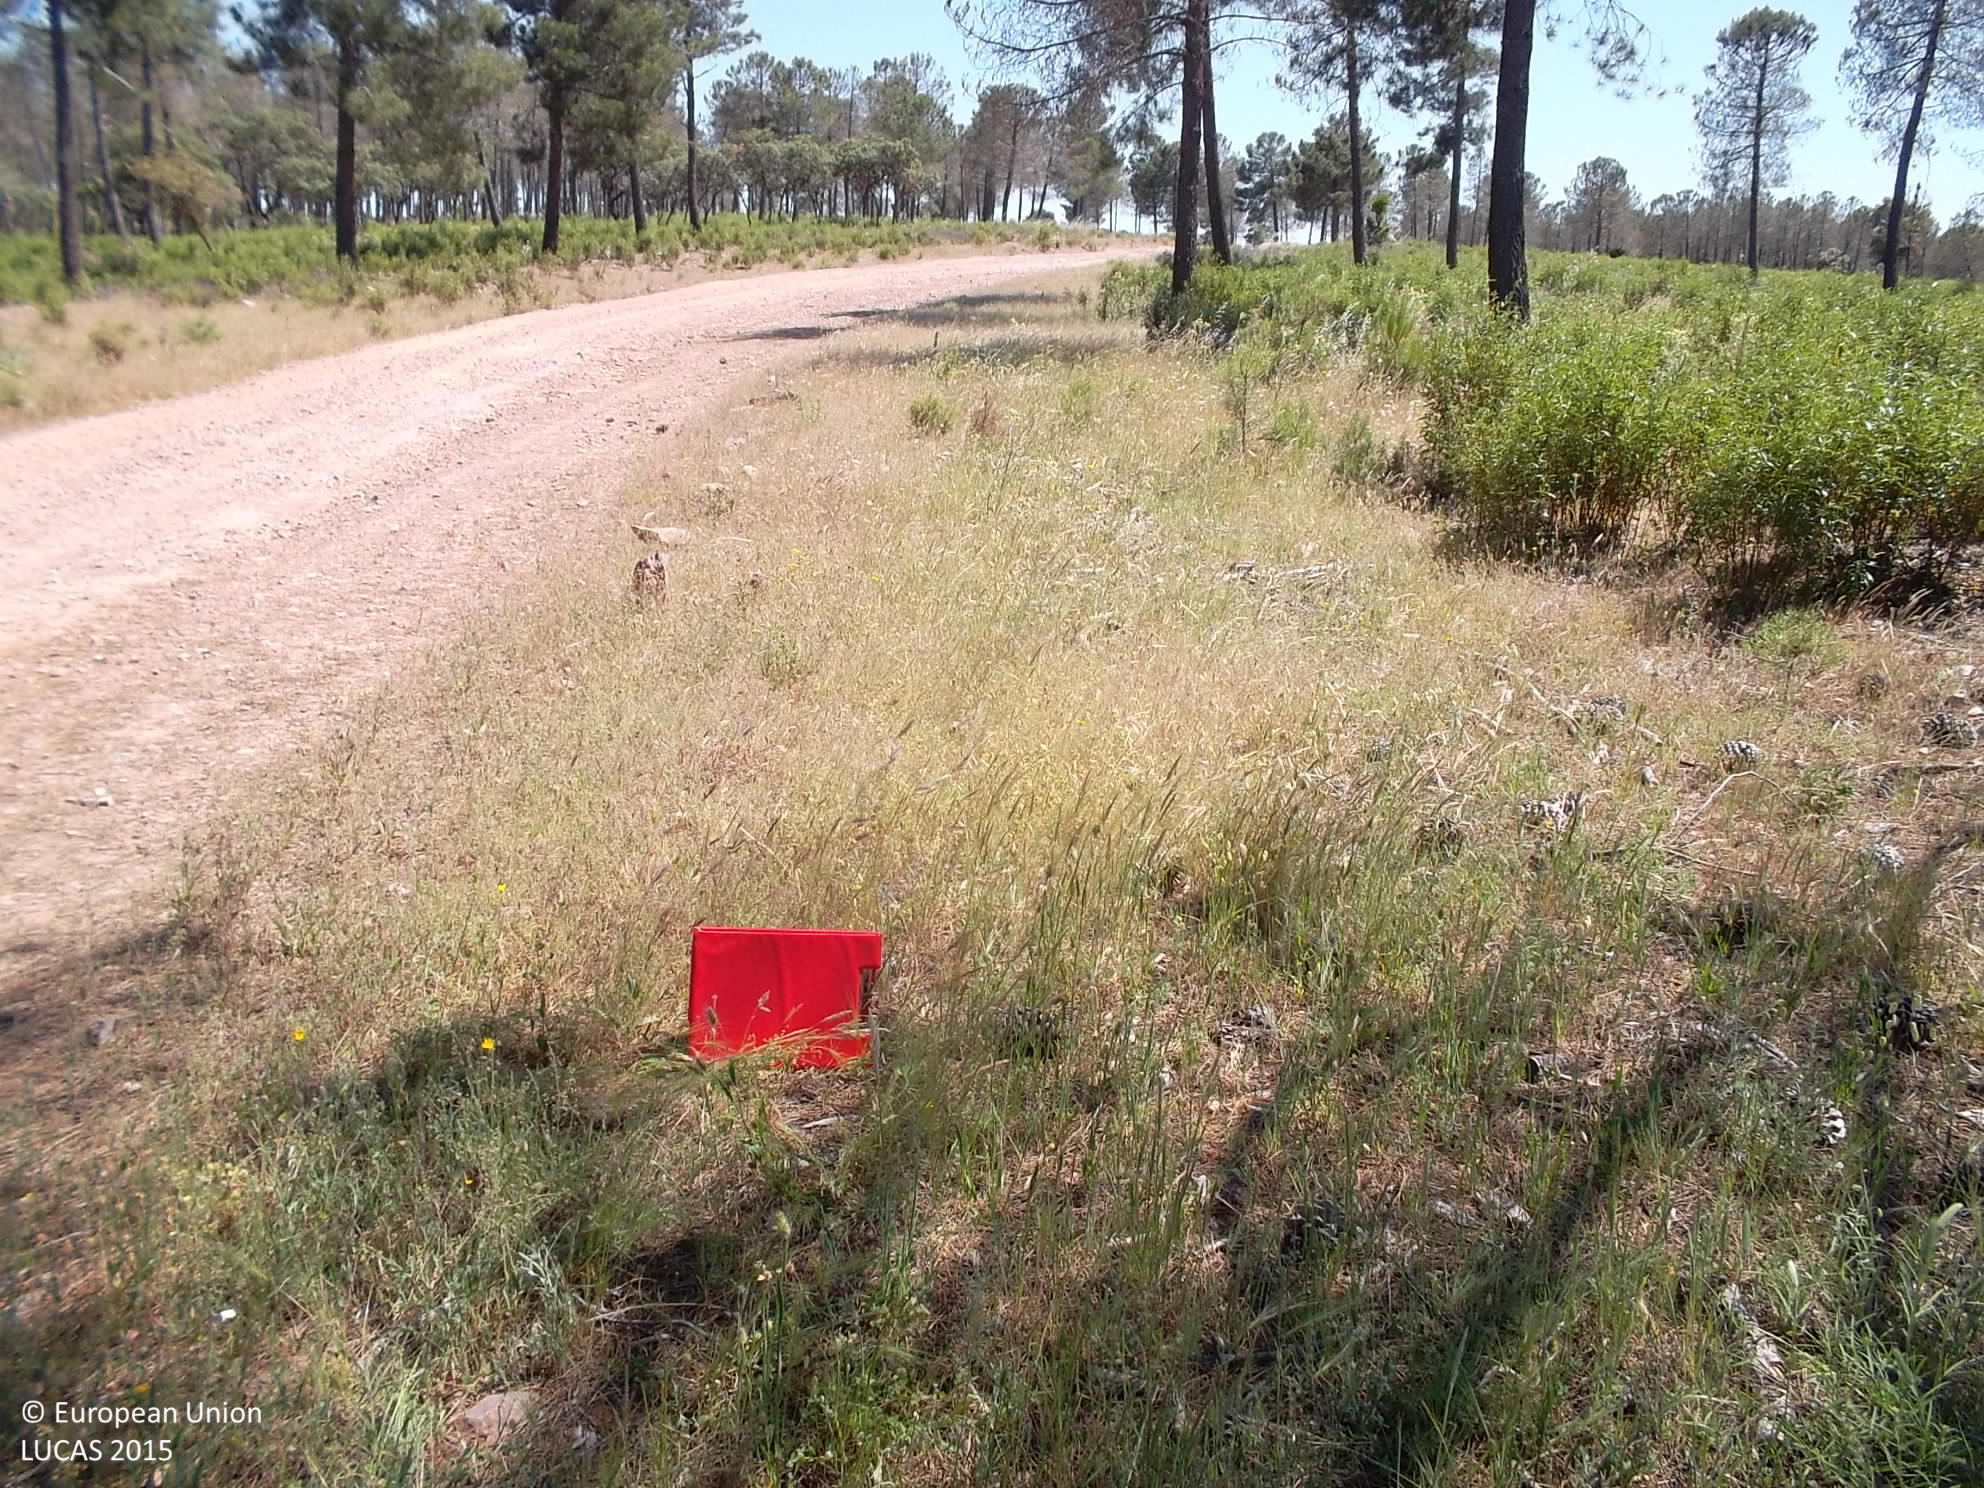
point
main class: Woodland
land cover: Pine dominated coniferous woodland
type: broadleaved evergreen forest
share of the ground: 25 - 50 %
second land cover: Spontaneously vegetated surfaces
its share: > 75 %
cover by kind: coniferous forest trees 40 %, herbaceous plants 30 %, consolidated bare surface 20 %, shrubs 10 %
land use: Forestry
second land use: Agriculture (excluding fallow land and kitchen gardens)
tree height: > 5 m
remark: Clear cut
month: May
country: ES
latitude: 38.8197
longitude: -4.4797
